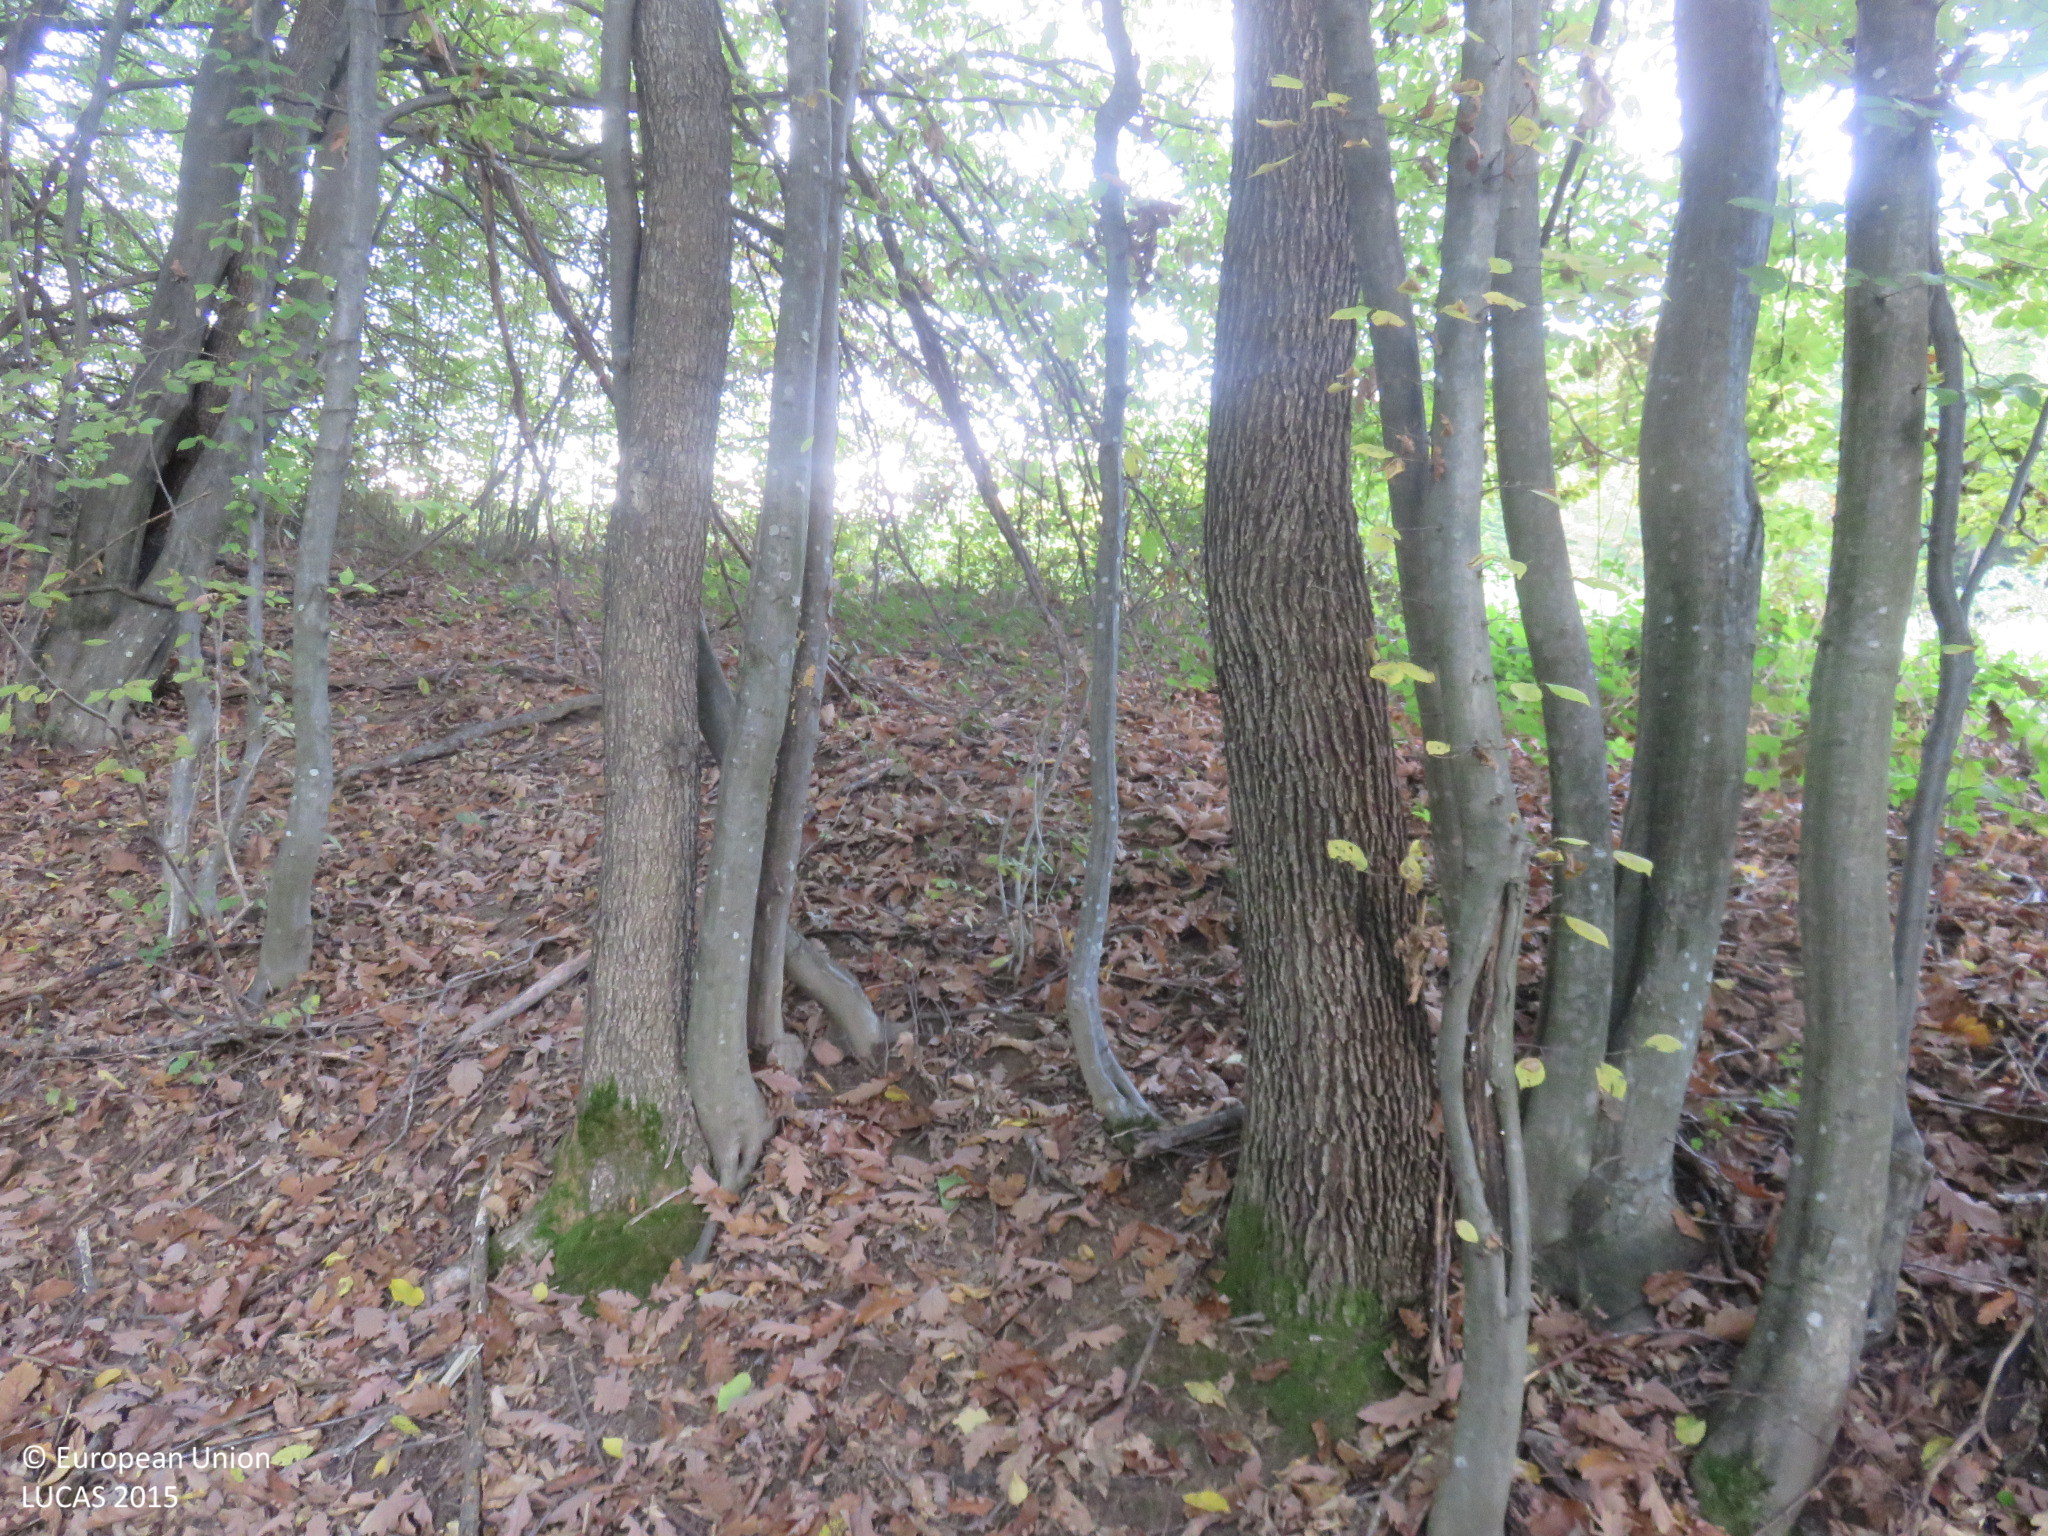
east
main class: Woodland
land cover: Broadleaved woodland
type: beech forest
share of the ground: > 75 %
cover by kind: broadleaved forest trees 95 %, shrubs 5 %
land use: Forestry
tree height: > 5 m
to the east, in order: Broadleaved woodland; Grassland without tree/shrub cover; Pine dominated coniferous woodland; Artificial constructions in urban areas; Broadleaved woodland
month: October
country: BG
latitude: 42.8384
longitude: 24.9528
